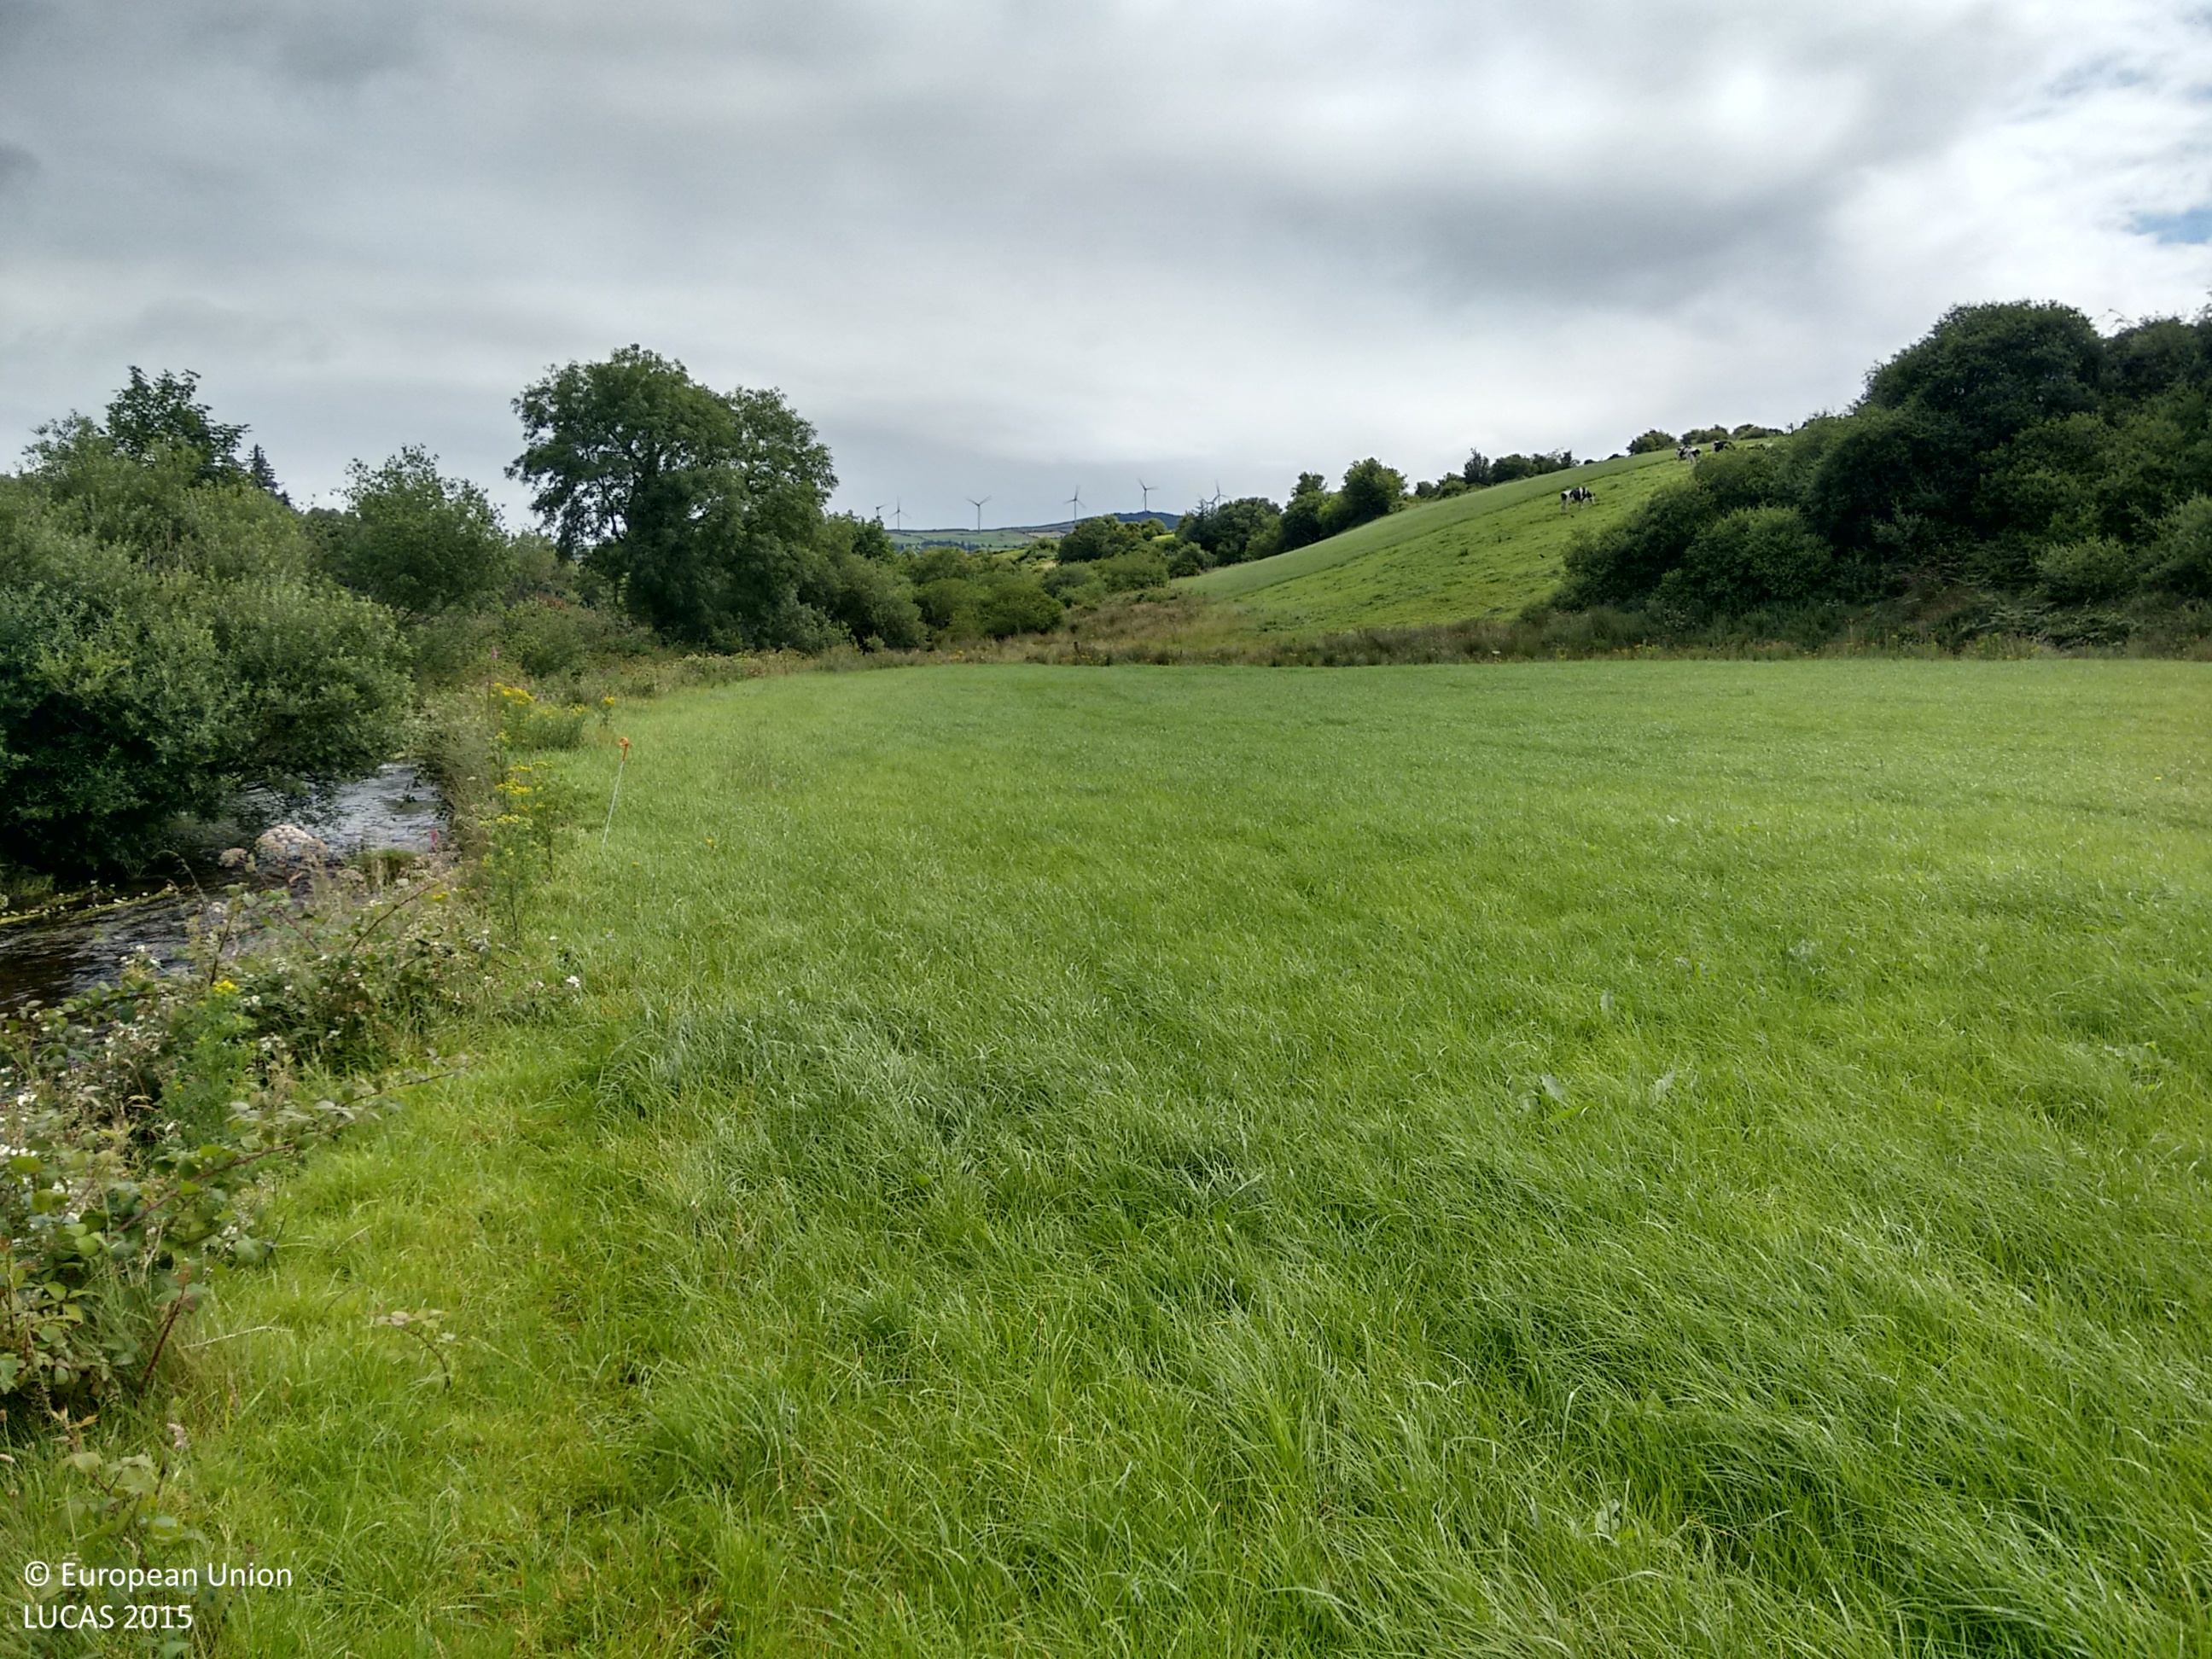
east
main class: Grassland
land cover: Grassland without tree/shrub cover
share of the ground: > 75 %
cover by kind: herbaceous plants 80 %, shrubs 5 %
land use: Agriculture (excluding fallow land and kitchen gardens)
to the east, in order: Grassland without tree/shrub cover; Fences; Grassland without tree/shrub cover; Grassland with sparse tree/shrub cover; Broadleaved woodland; Shrubland with sparse tree cover
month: July
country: IE
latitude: 52.0682
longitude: -8.9570
